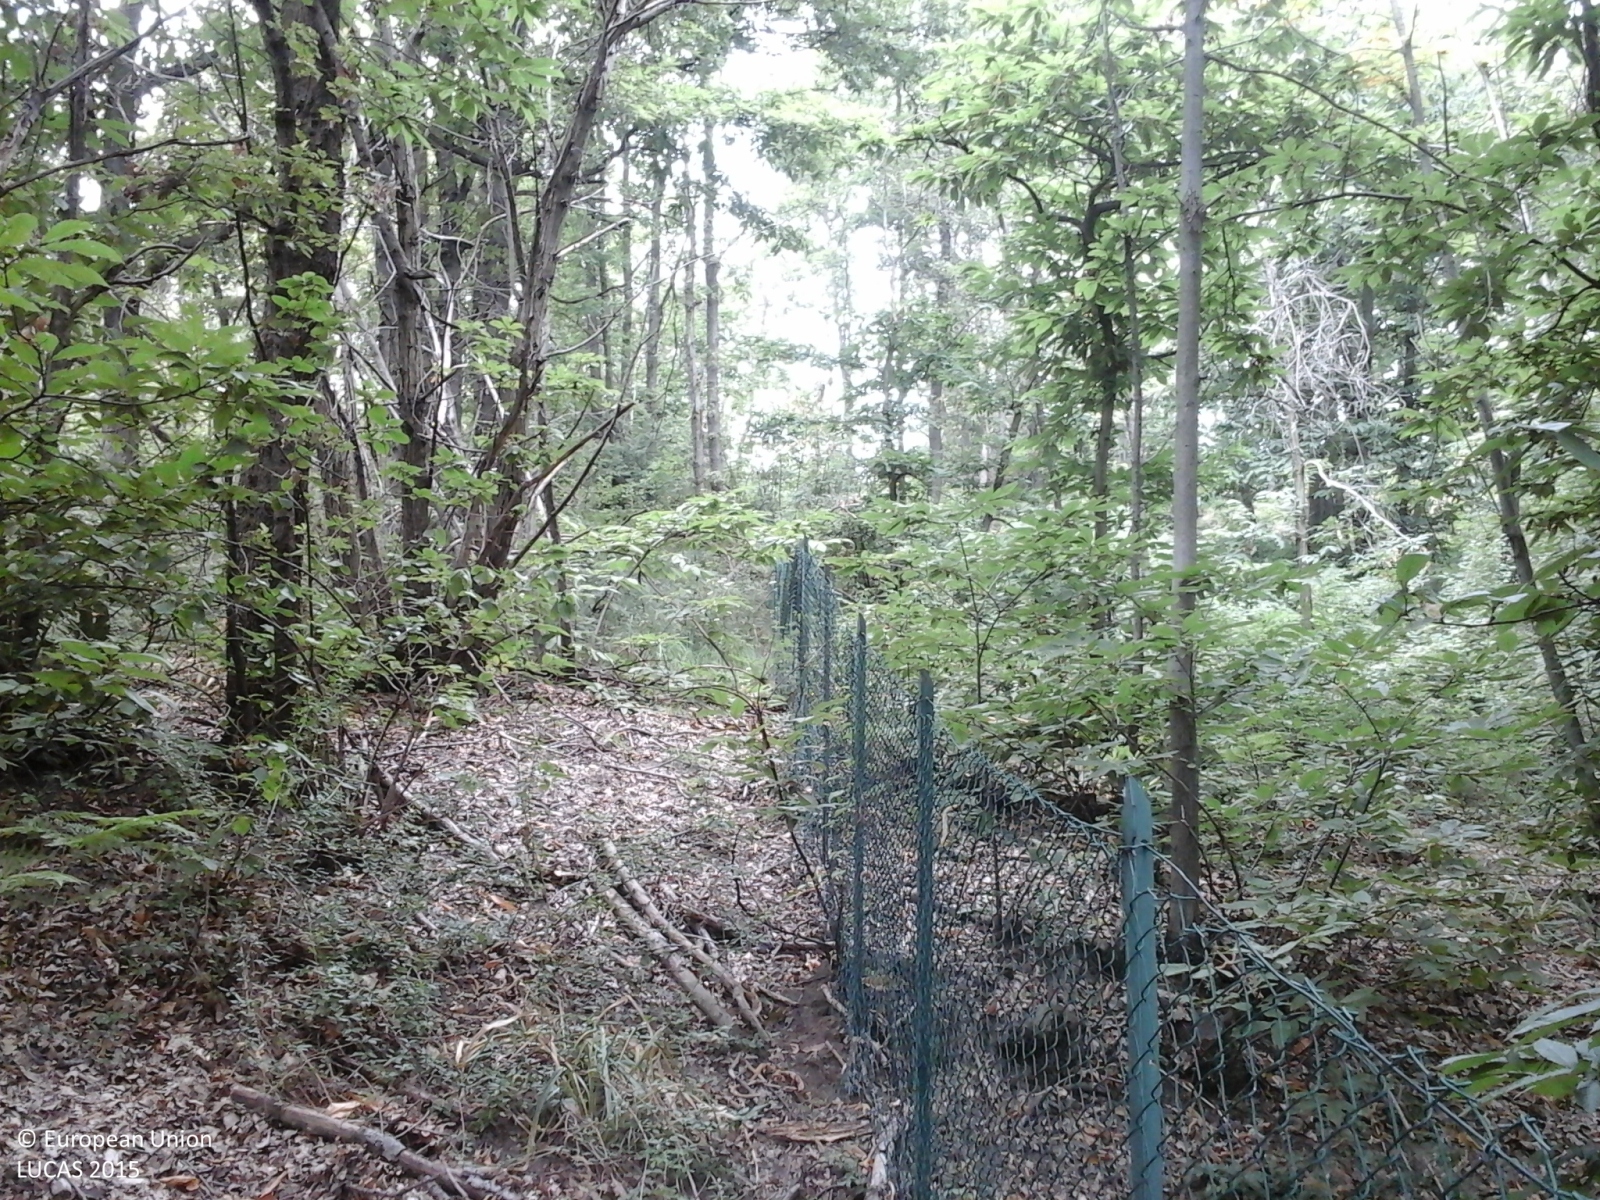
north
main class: Woodland
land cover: Broadleaved woodland
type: thermophilous deciduous forest
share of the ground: > 75 %
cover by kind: broadleaved forest trees 100 %
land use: Semi-natural and natural areas not in use
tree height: > 5 m
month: July
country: IT
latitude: 45.0664
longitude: 7.7813
